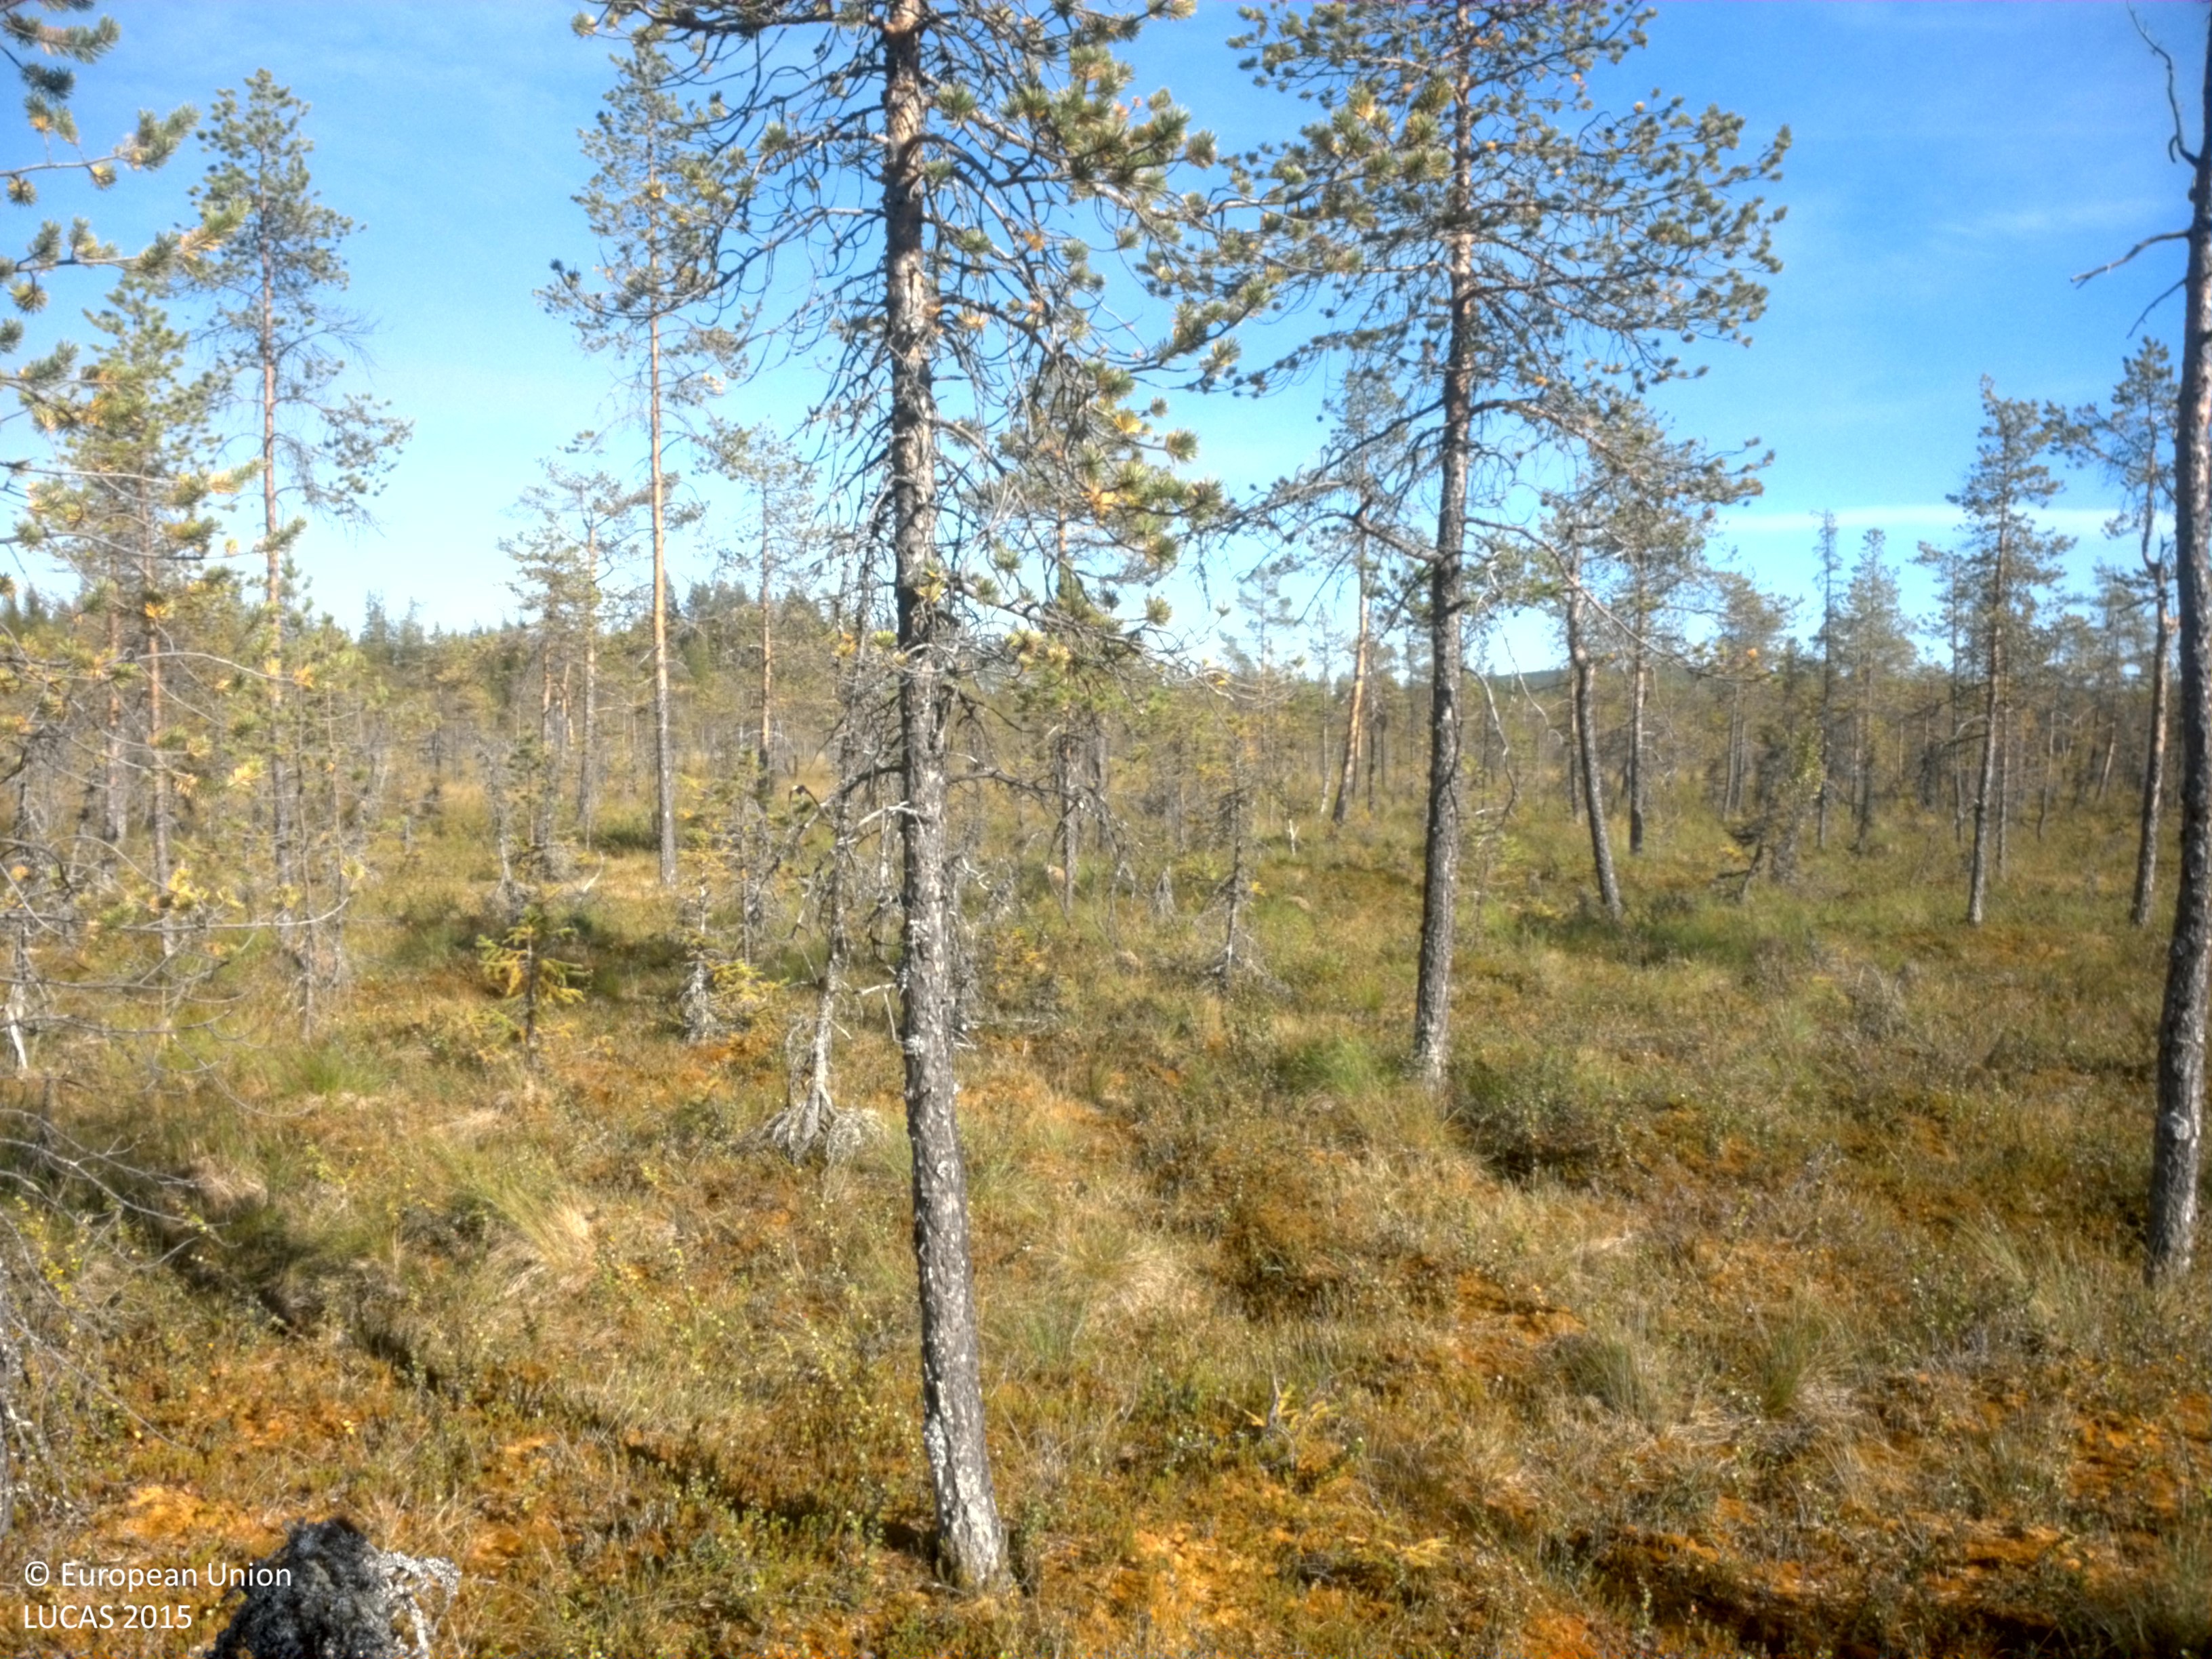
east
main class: Woodland
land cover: Pine dominated coniferous woodland
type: boreal forest
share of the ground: 25 - 50 %
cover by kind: coniferous forest trees 35 %, herbaceous plants 25 %, shrubs 20 %, lichens and mosses 20 %
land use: Semi-natural and natural areas not in use
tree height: > 5 m
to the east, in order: Pine dominated coniferous woodland
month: August
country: SE
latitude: 64.5183
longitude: 18.4469
